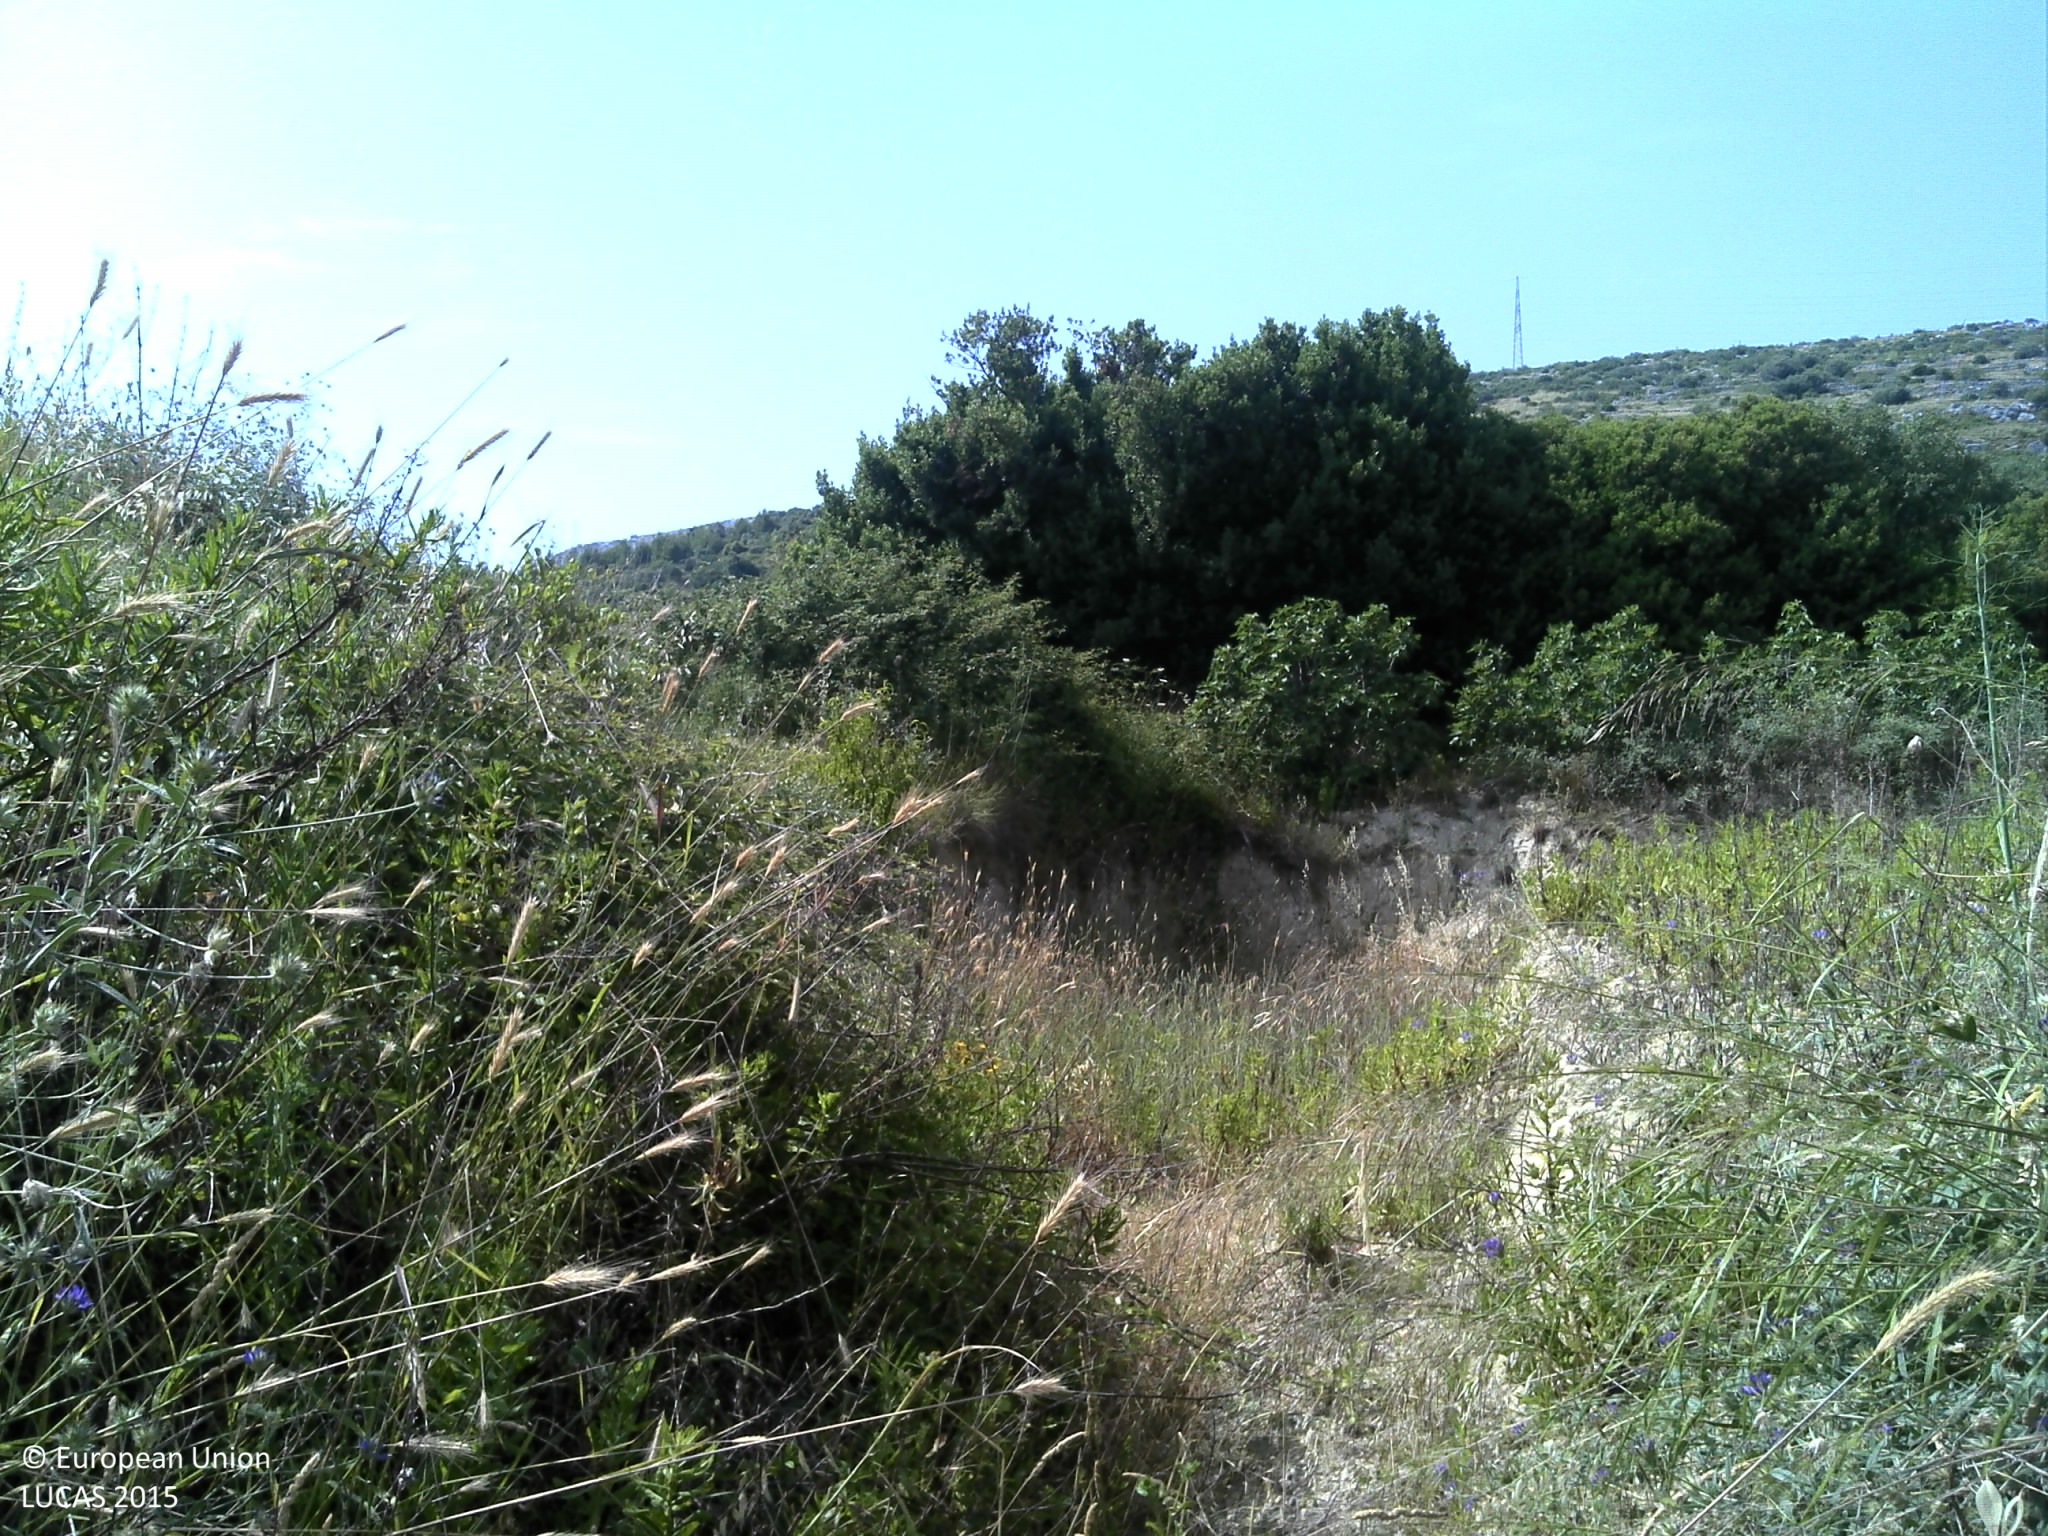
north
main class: Grassland
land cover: Grassland without tree/shrub cover
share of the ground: > 75 %
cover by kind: herbaceous plants 80 %, unconsolidated bare surface 15 %, shrubs 5 %
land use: Abandoned areas
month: June
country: HR
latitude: 43.5281
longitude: 16.2639
